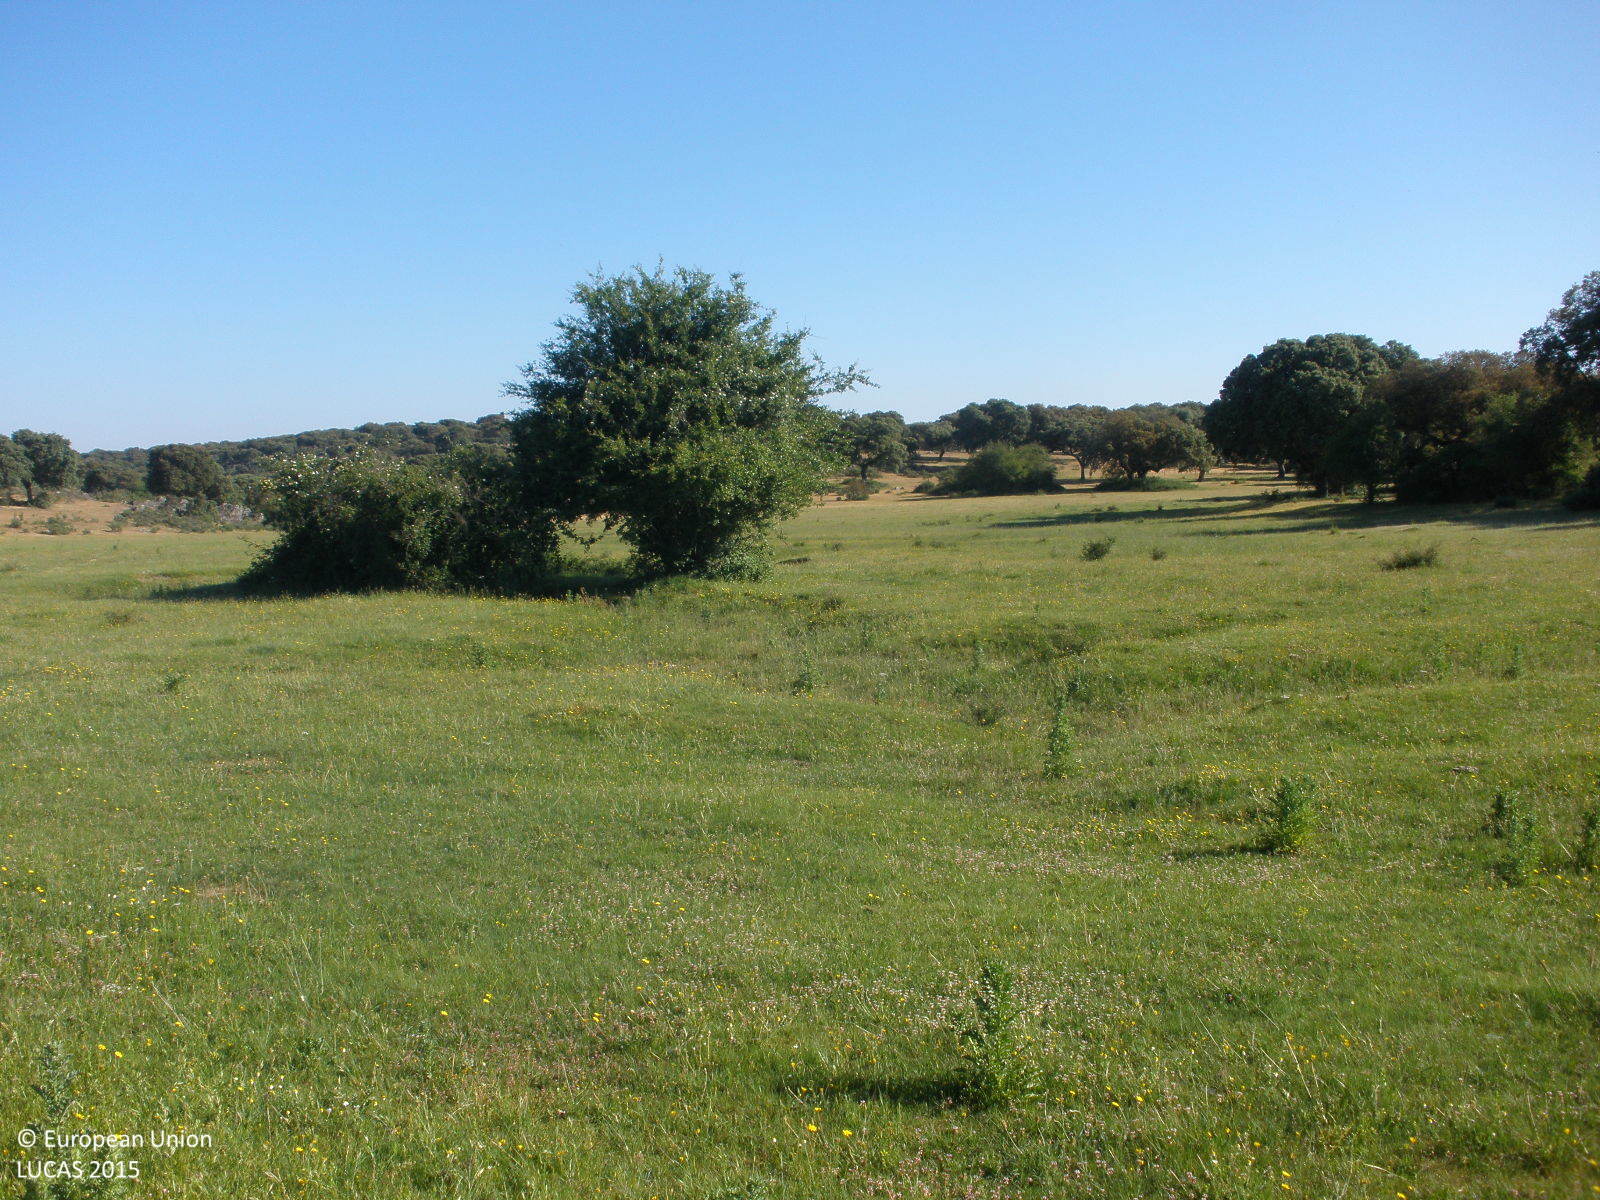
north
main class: Grassland
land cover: Grassland without tree/shrub cover
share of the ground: > 75 %
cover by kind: herbaceous plants 100 %
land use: Agriculture (excluding fallow land and kitchen gardens)
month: June
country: ES
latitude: 40.4572
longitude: -6.6344
